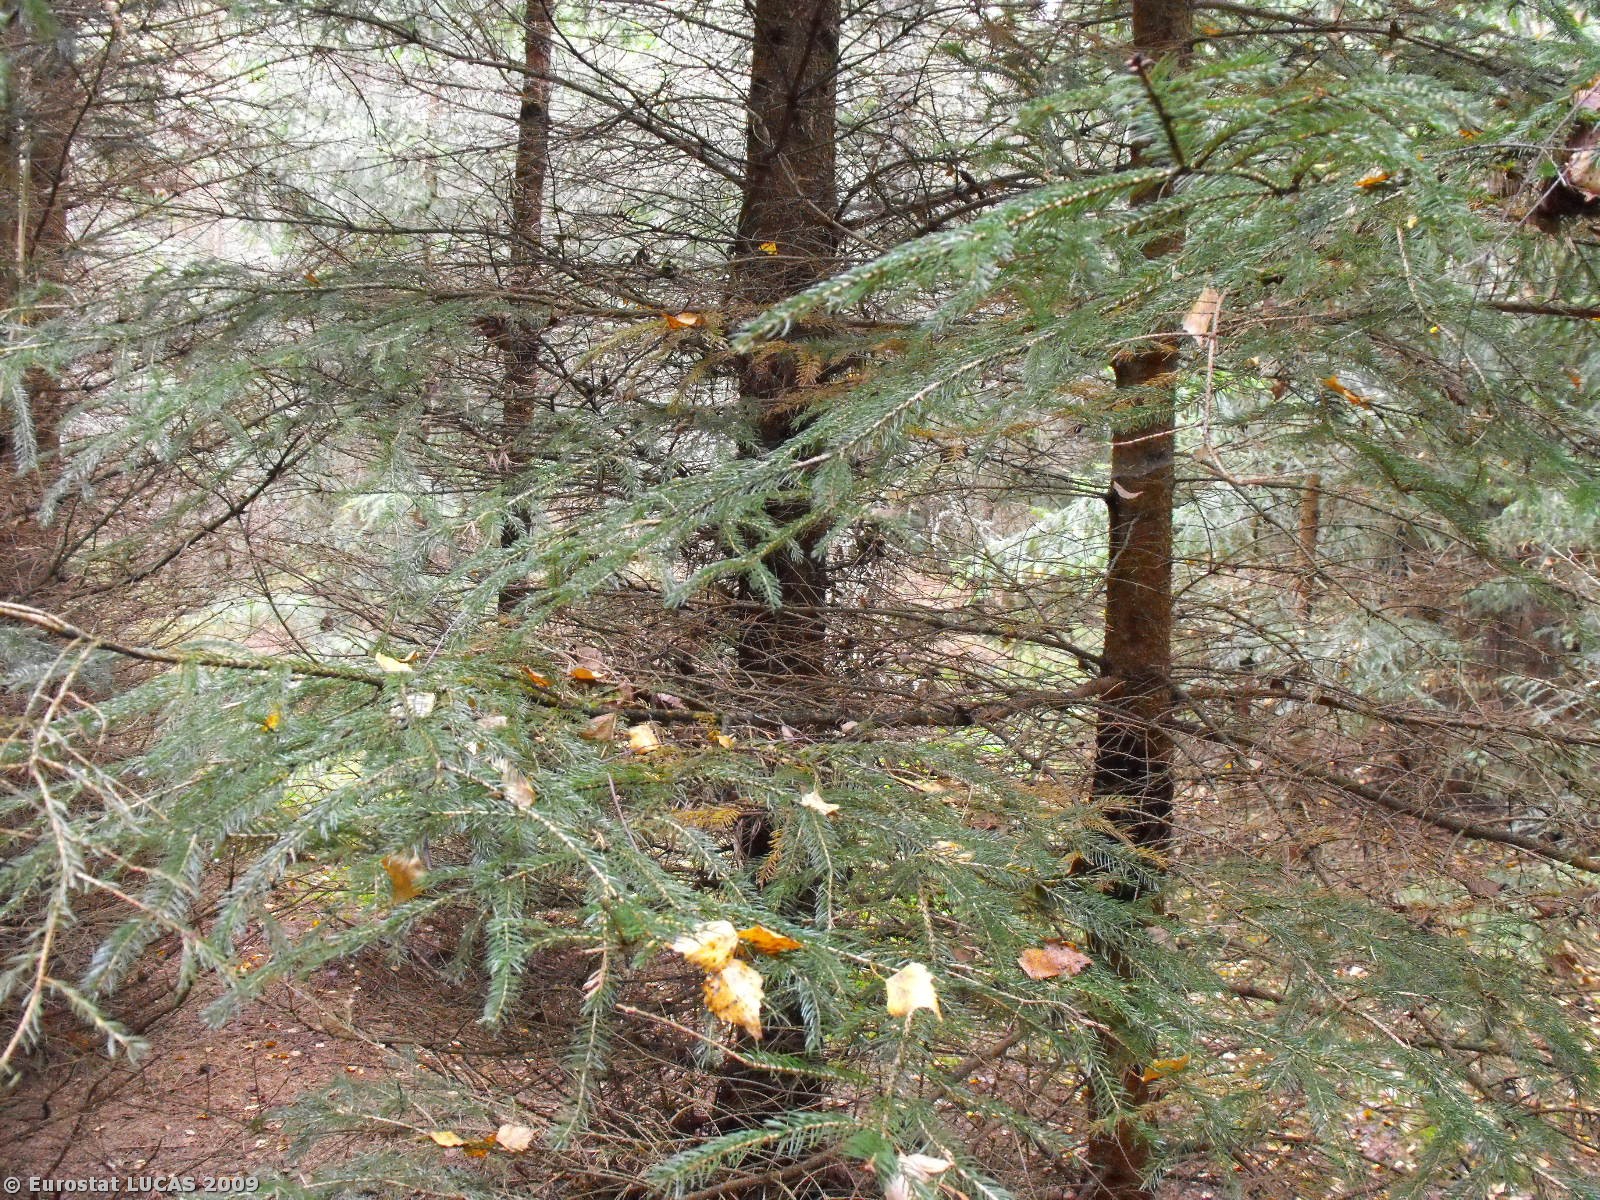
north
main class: Woodland
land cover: Coniferous woodland
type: hemiboreal forest and nemoral coniferous forest and mixed broadleaved-coniferous forest
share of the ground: > 75 %
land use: Forestry
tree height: > 5 m
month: September
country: PL
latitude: 53.1041
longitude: 16.4445
